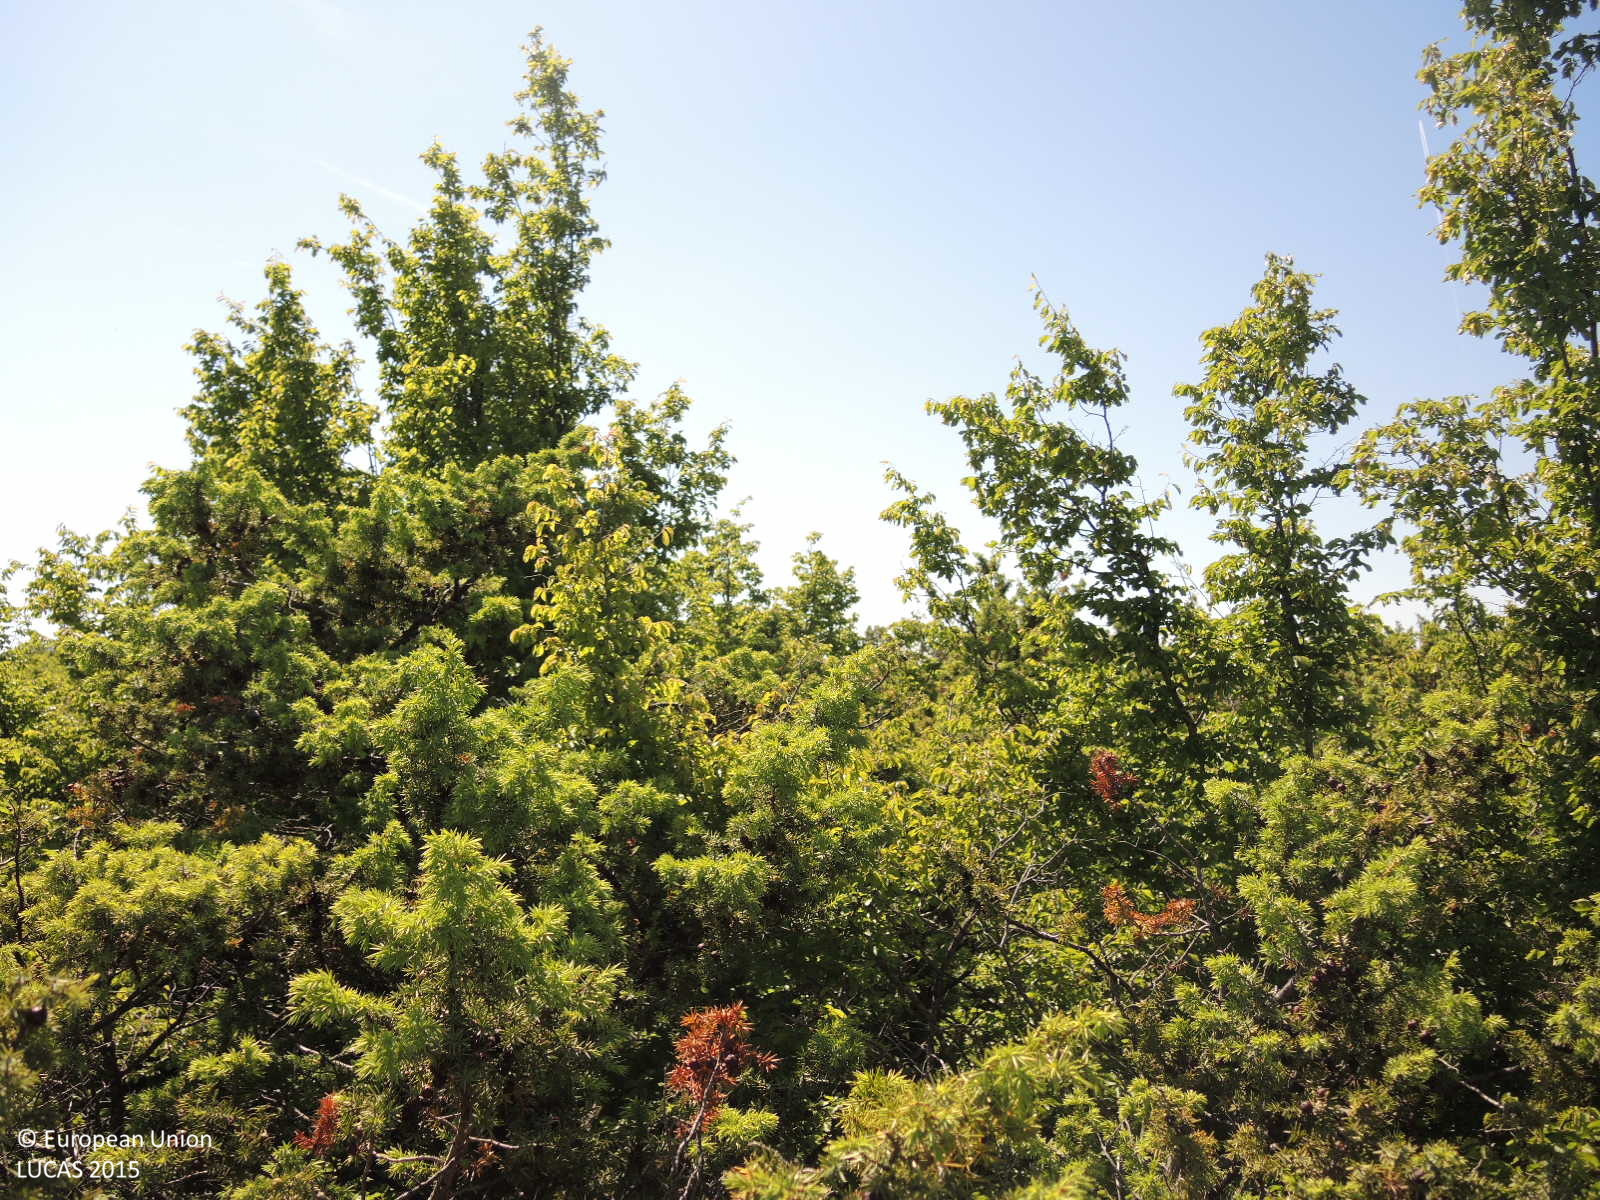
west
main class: Shrubland
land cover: Shrubland with sparse tree cover
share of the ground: > 75 %
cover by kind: shrubs 85 %, coniferous forest trees 5 %, herbaceous plants 5 %, unconsolidated bare surface 5 %
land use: Semi-natural and natural areas not in use
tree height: < 5 m
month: May
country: HR
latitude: 43.9456
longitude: 15.9350
